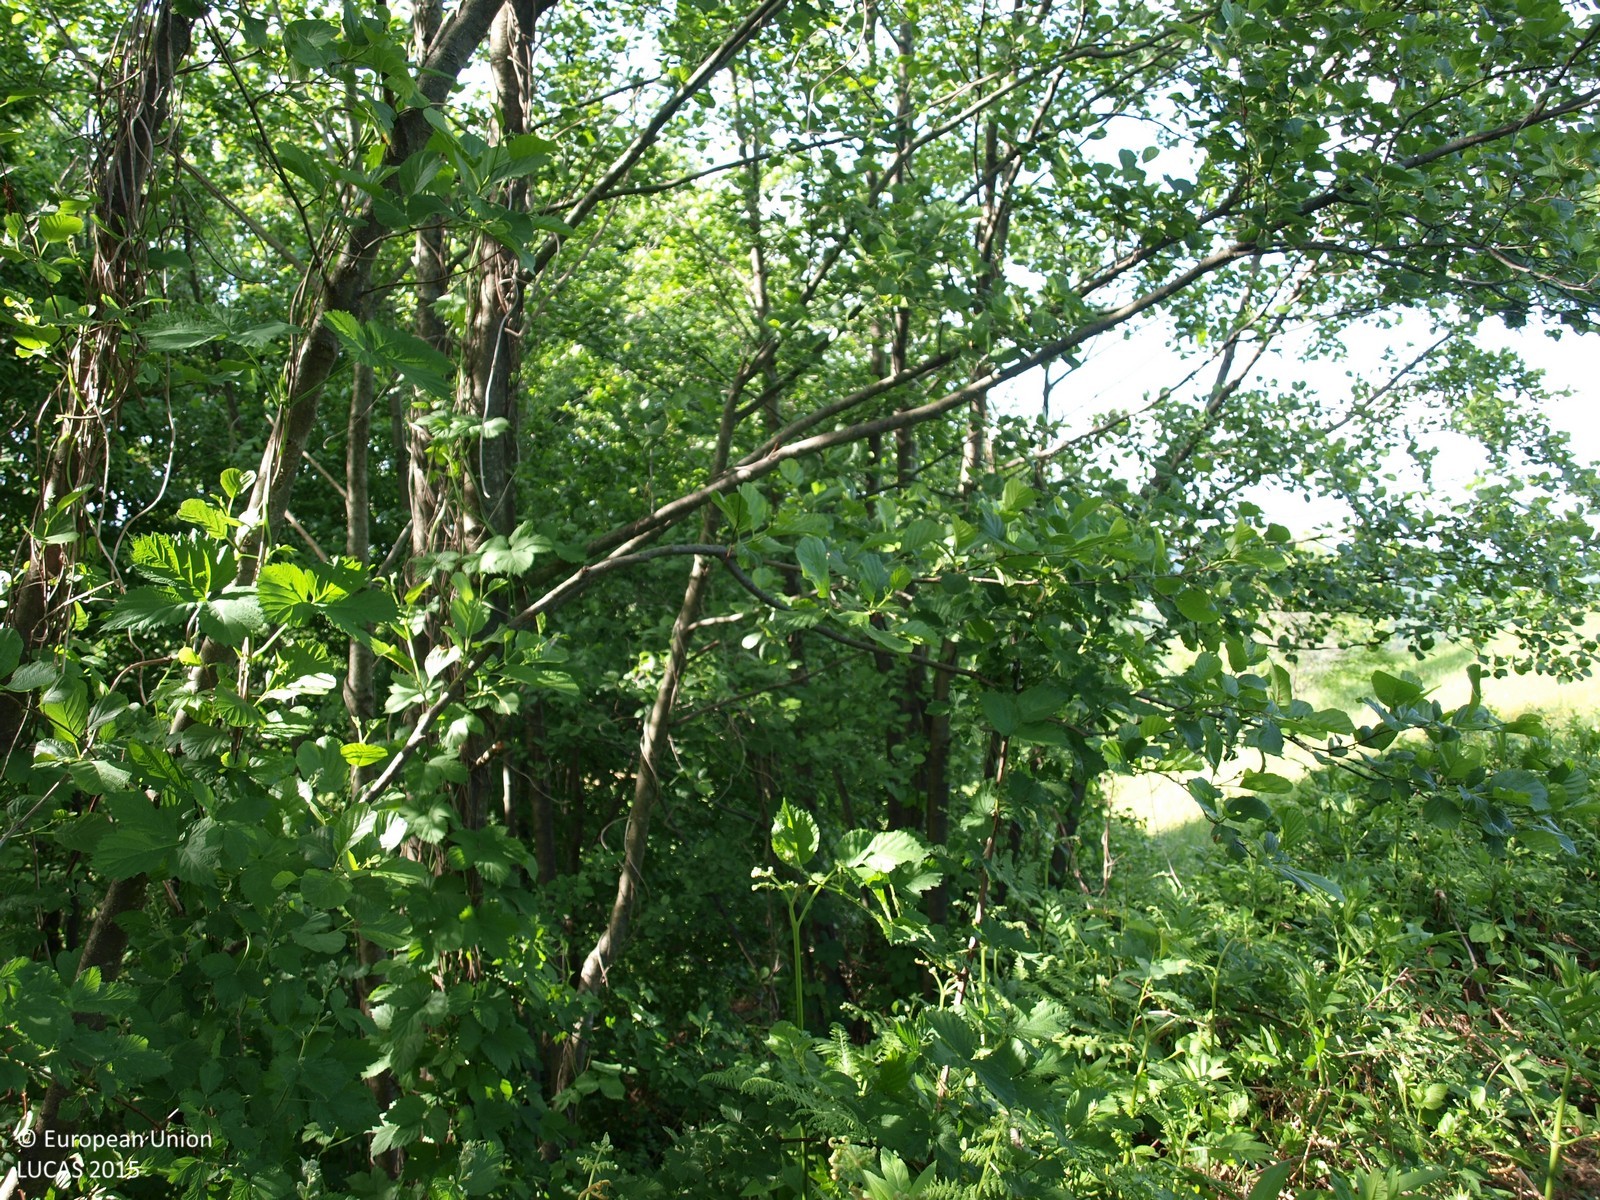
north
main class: Woodland
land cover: Broadleaved woodland
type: mesophytic deciduous forest
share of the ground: > 75 %
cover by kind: broadleaved forest trees 60 %, shrubs 30 %, herbaceous plants 10 %
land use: Forestry
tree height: > 5 m
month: May
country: HR
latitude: 46.2246
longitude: 15.8979
